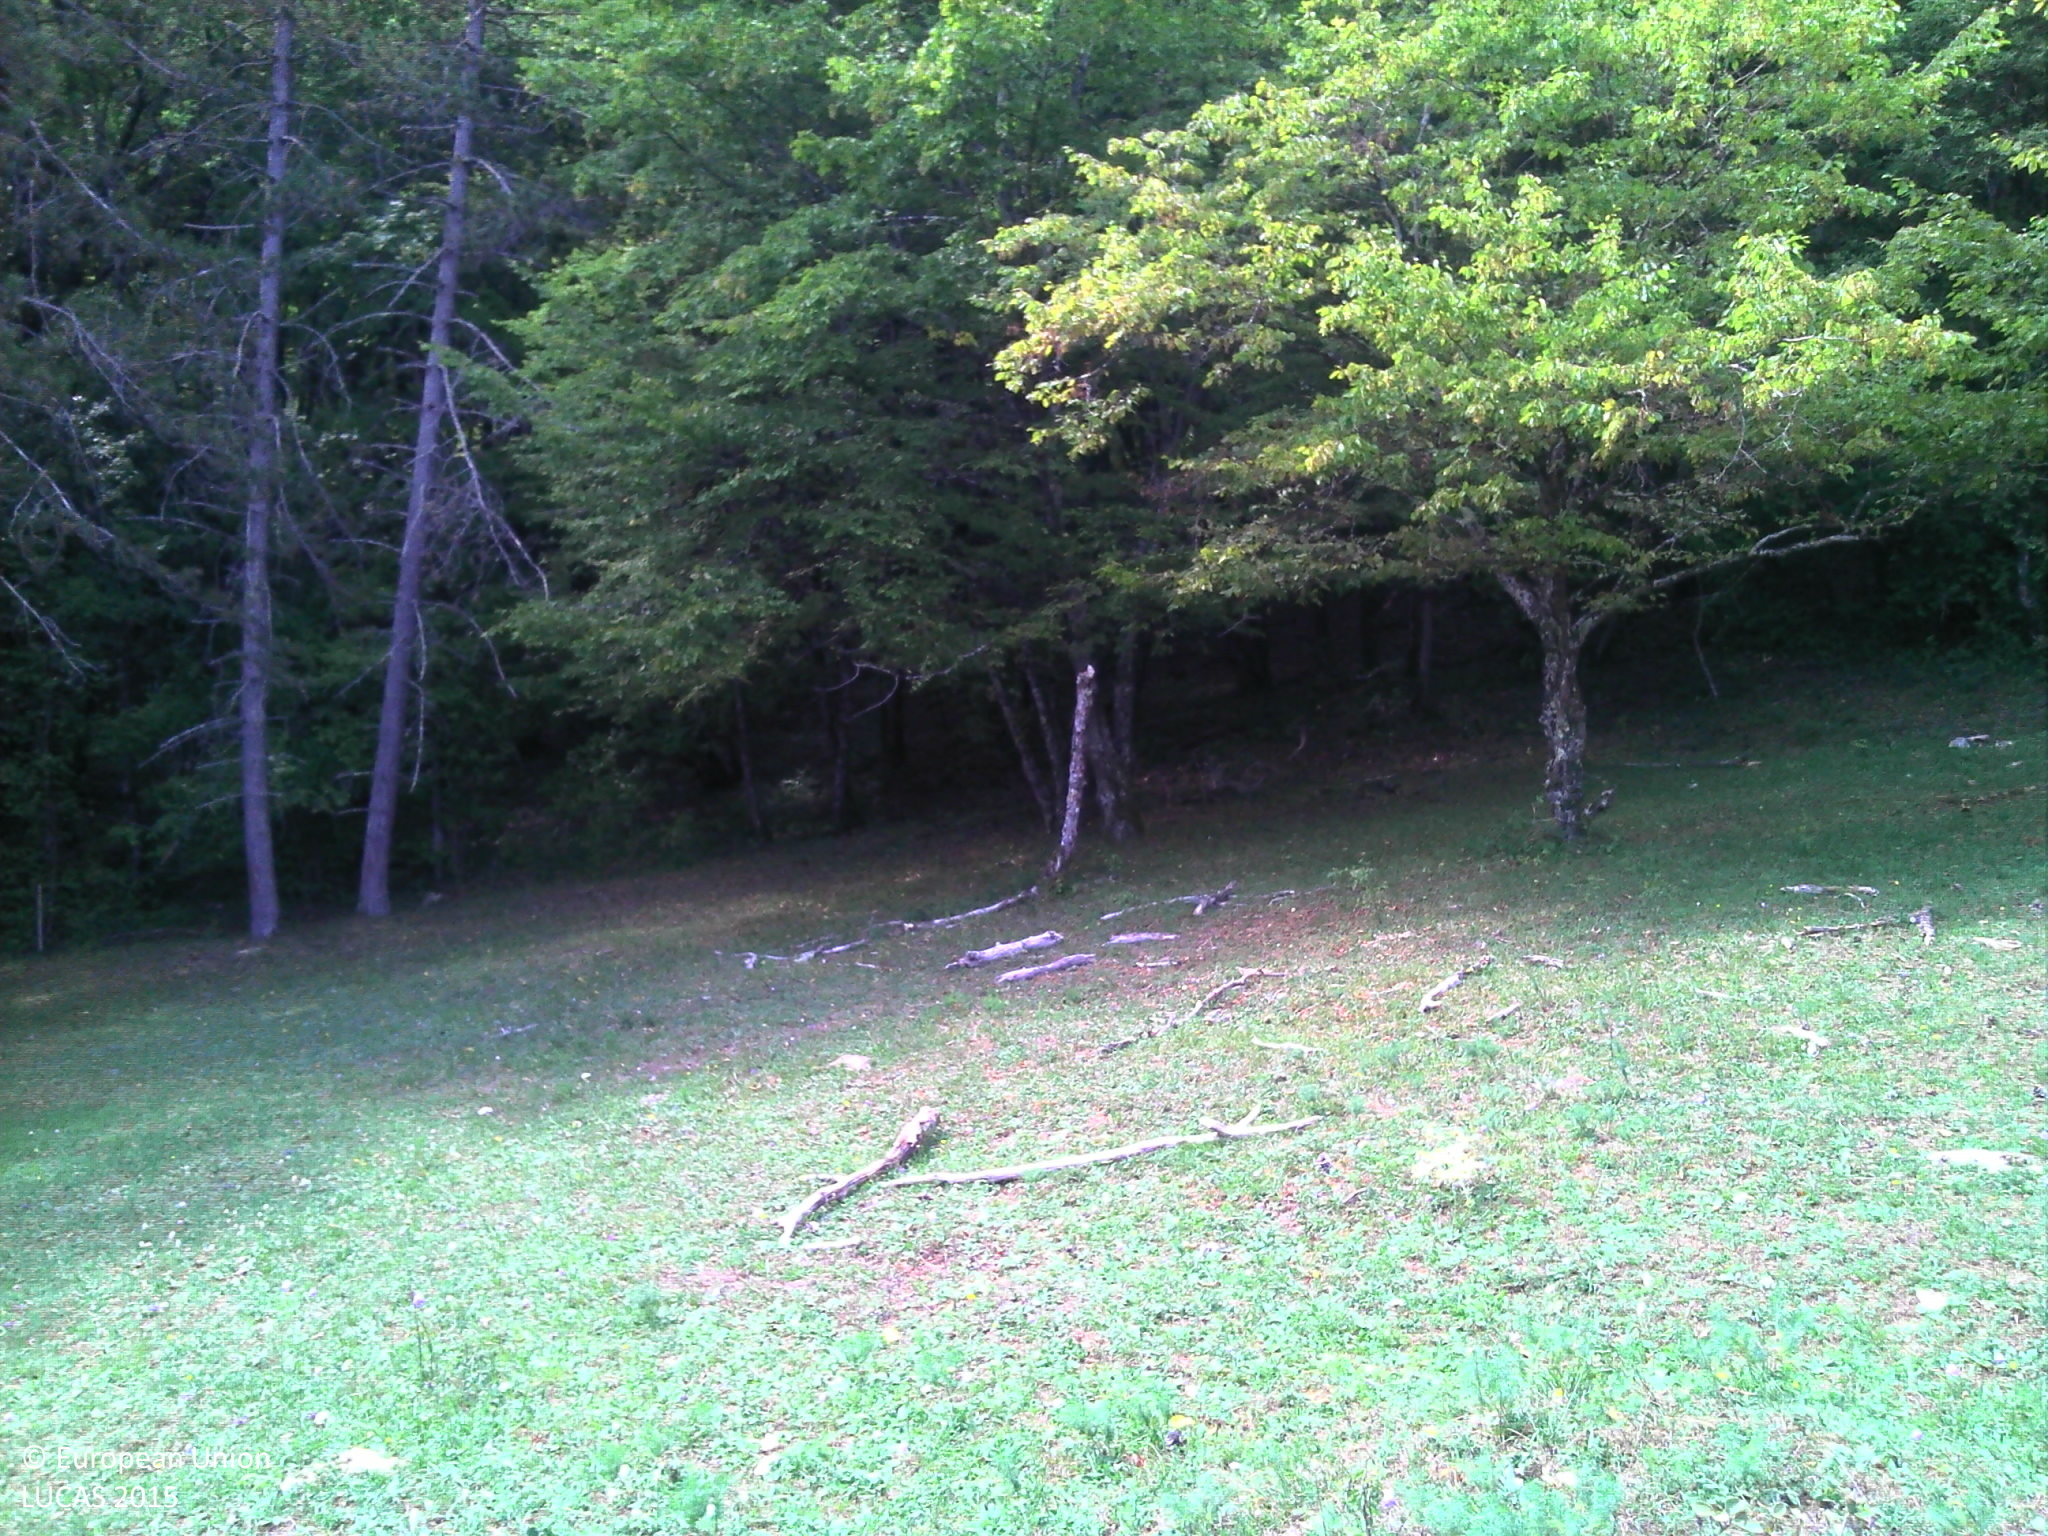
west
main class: Grassland
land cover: Grassland without tree/shrub cover
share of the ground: > 75 %
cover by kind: herbaceous plants 100 %
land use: Agriculture (excluding fallow land and kitchen gardens)
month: August
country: FR
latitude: 47.2318
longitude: 4.7300
